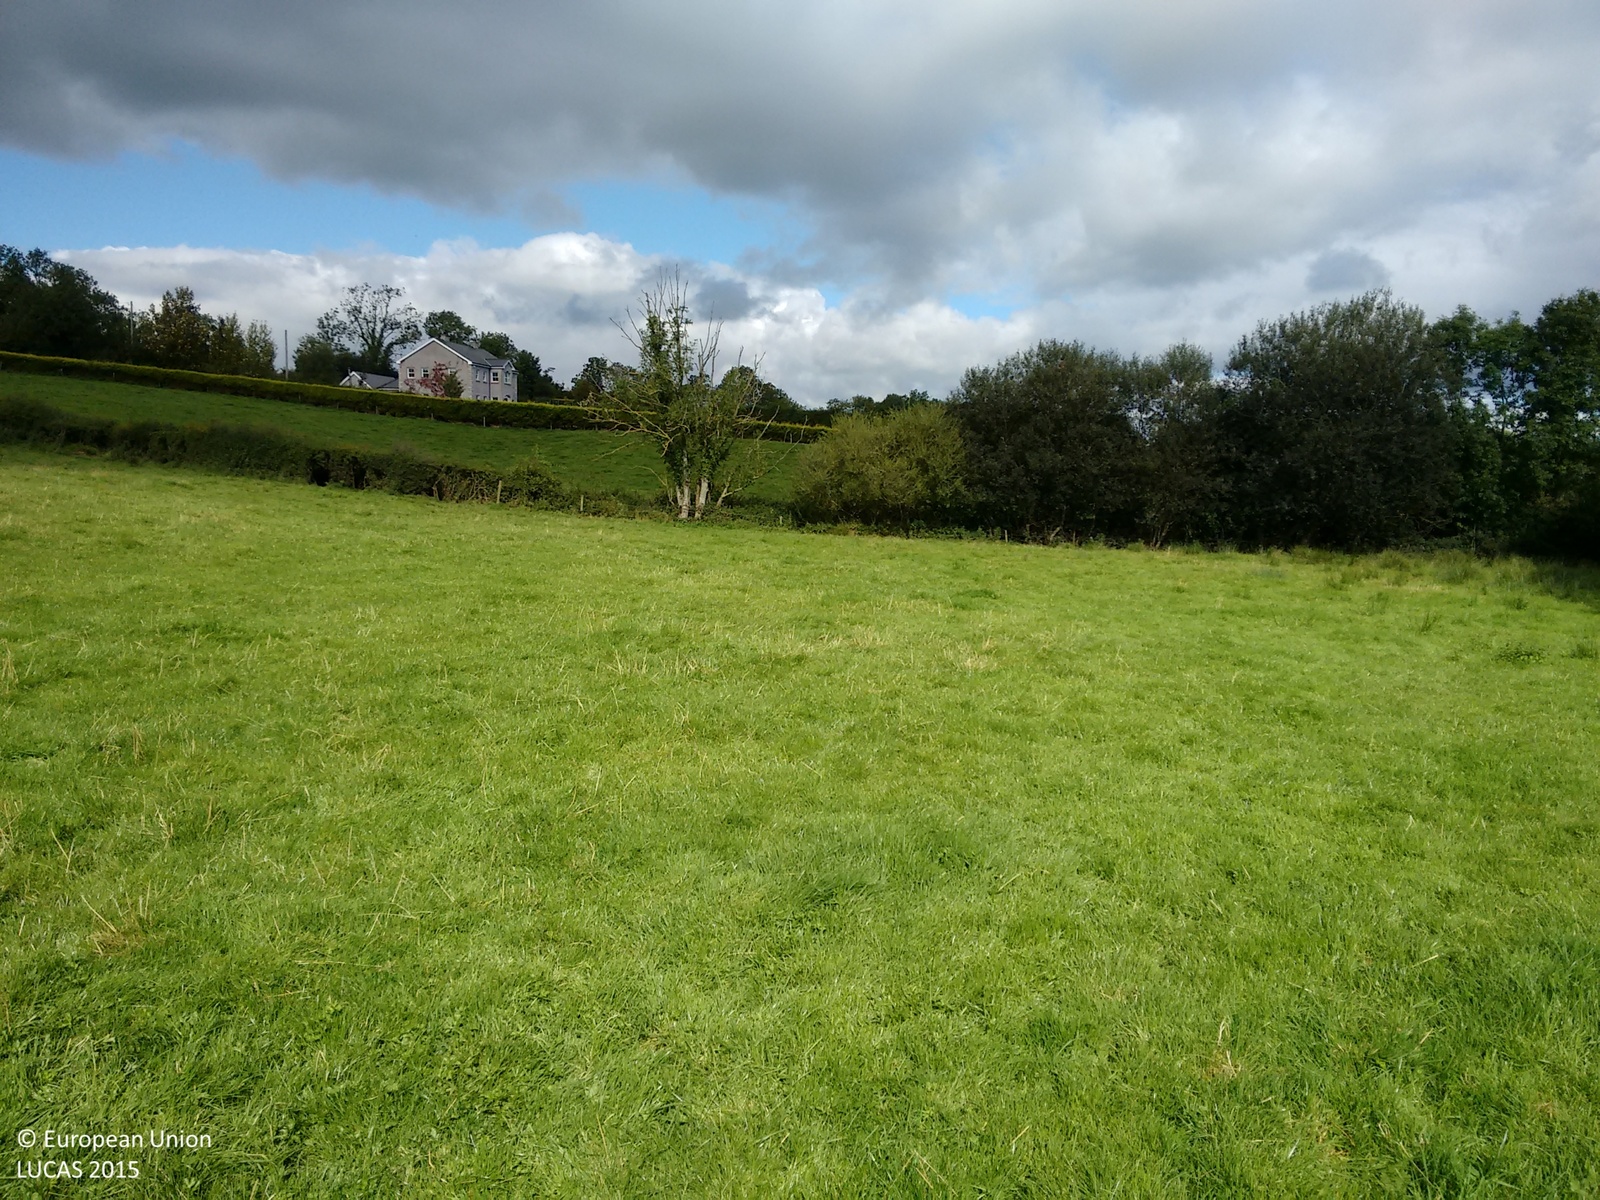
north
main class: Grassland
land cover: Grassland without tree/shrub cover
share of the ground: > 75 %
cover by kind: herbaceous plants 95 %, shrubs 5 %
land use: Agriculture (excluding fallow land and kitchen gardens)
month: September
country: IE
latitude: 54.2774
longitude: -6.9241
